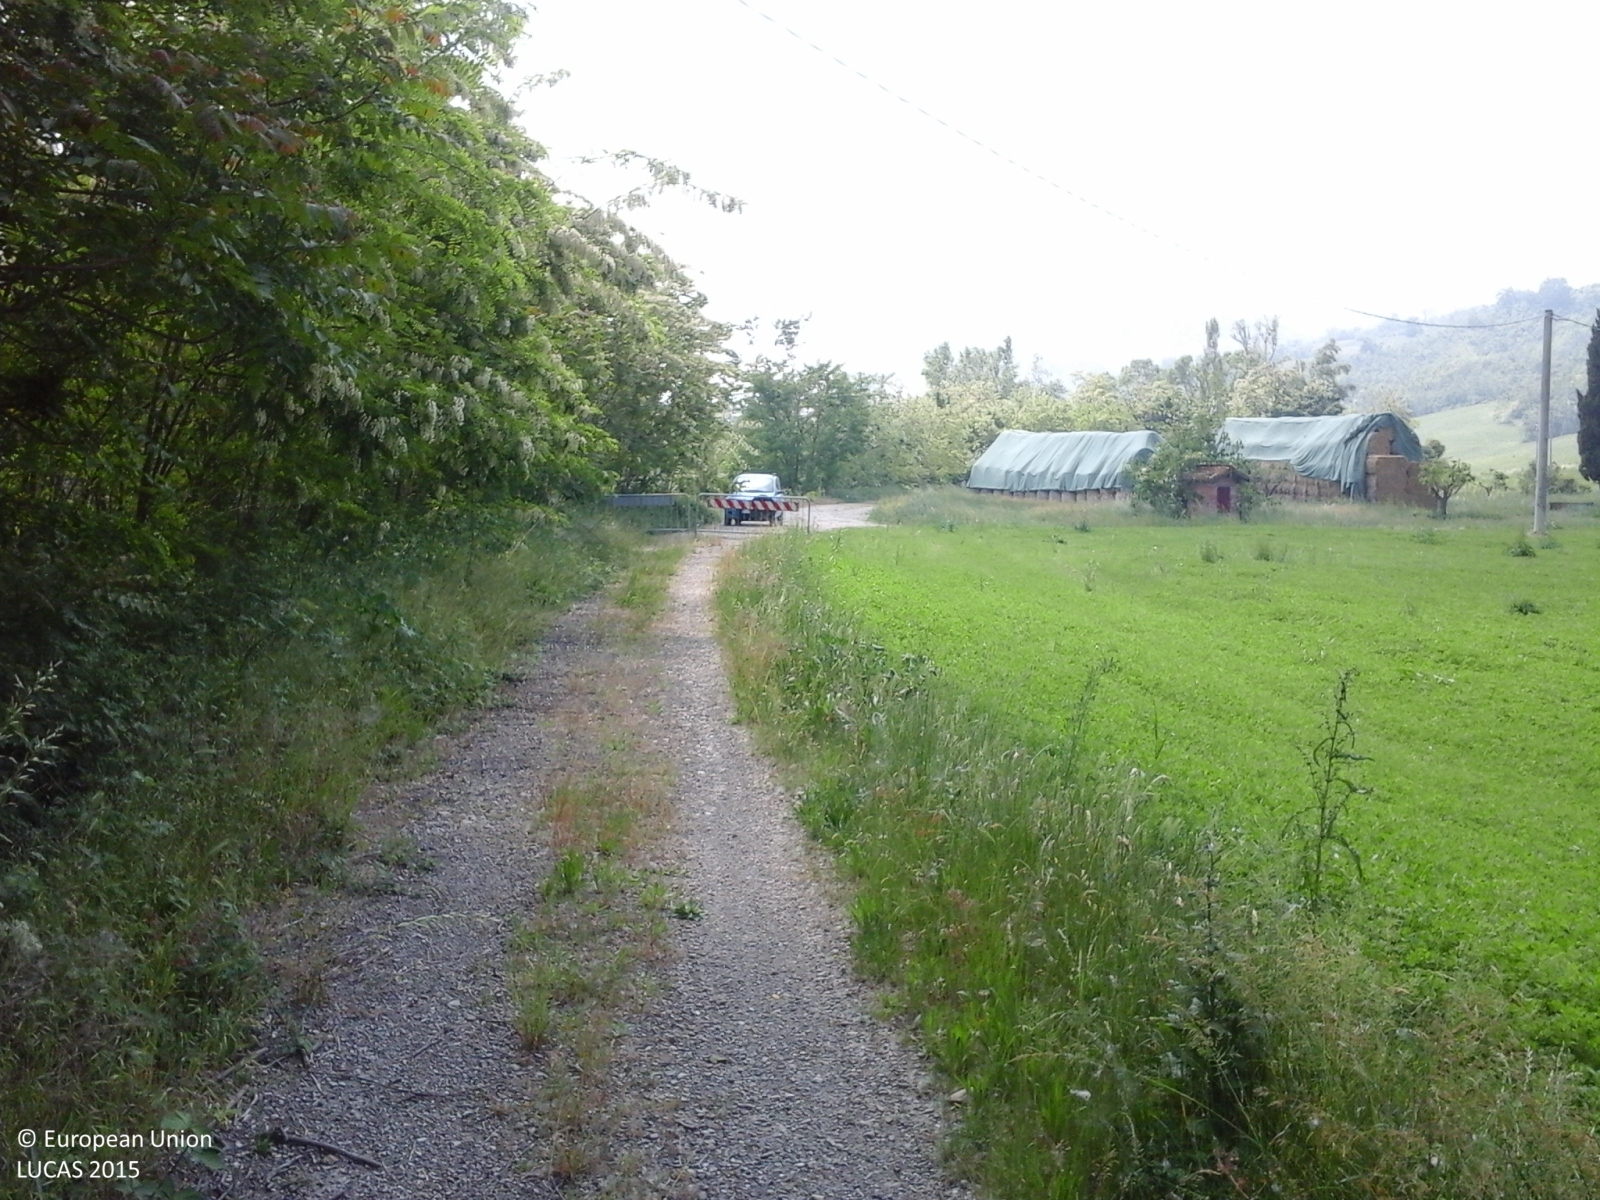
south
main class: Woodland
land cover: Broadleaved woodland
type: mesophytic deciduous forest
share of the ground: > 75 %
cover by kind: broadleaved forest trees 100 %
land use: Semi-natural and natural areas not in use
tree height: > 5 m
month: May
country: IT
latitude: 44.4912
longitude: 10.8658
